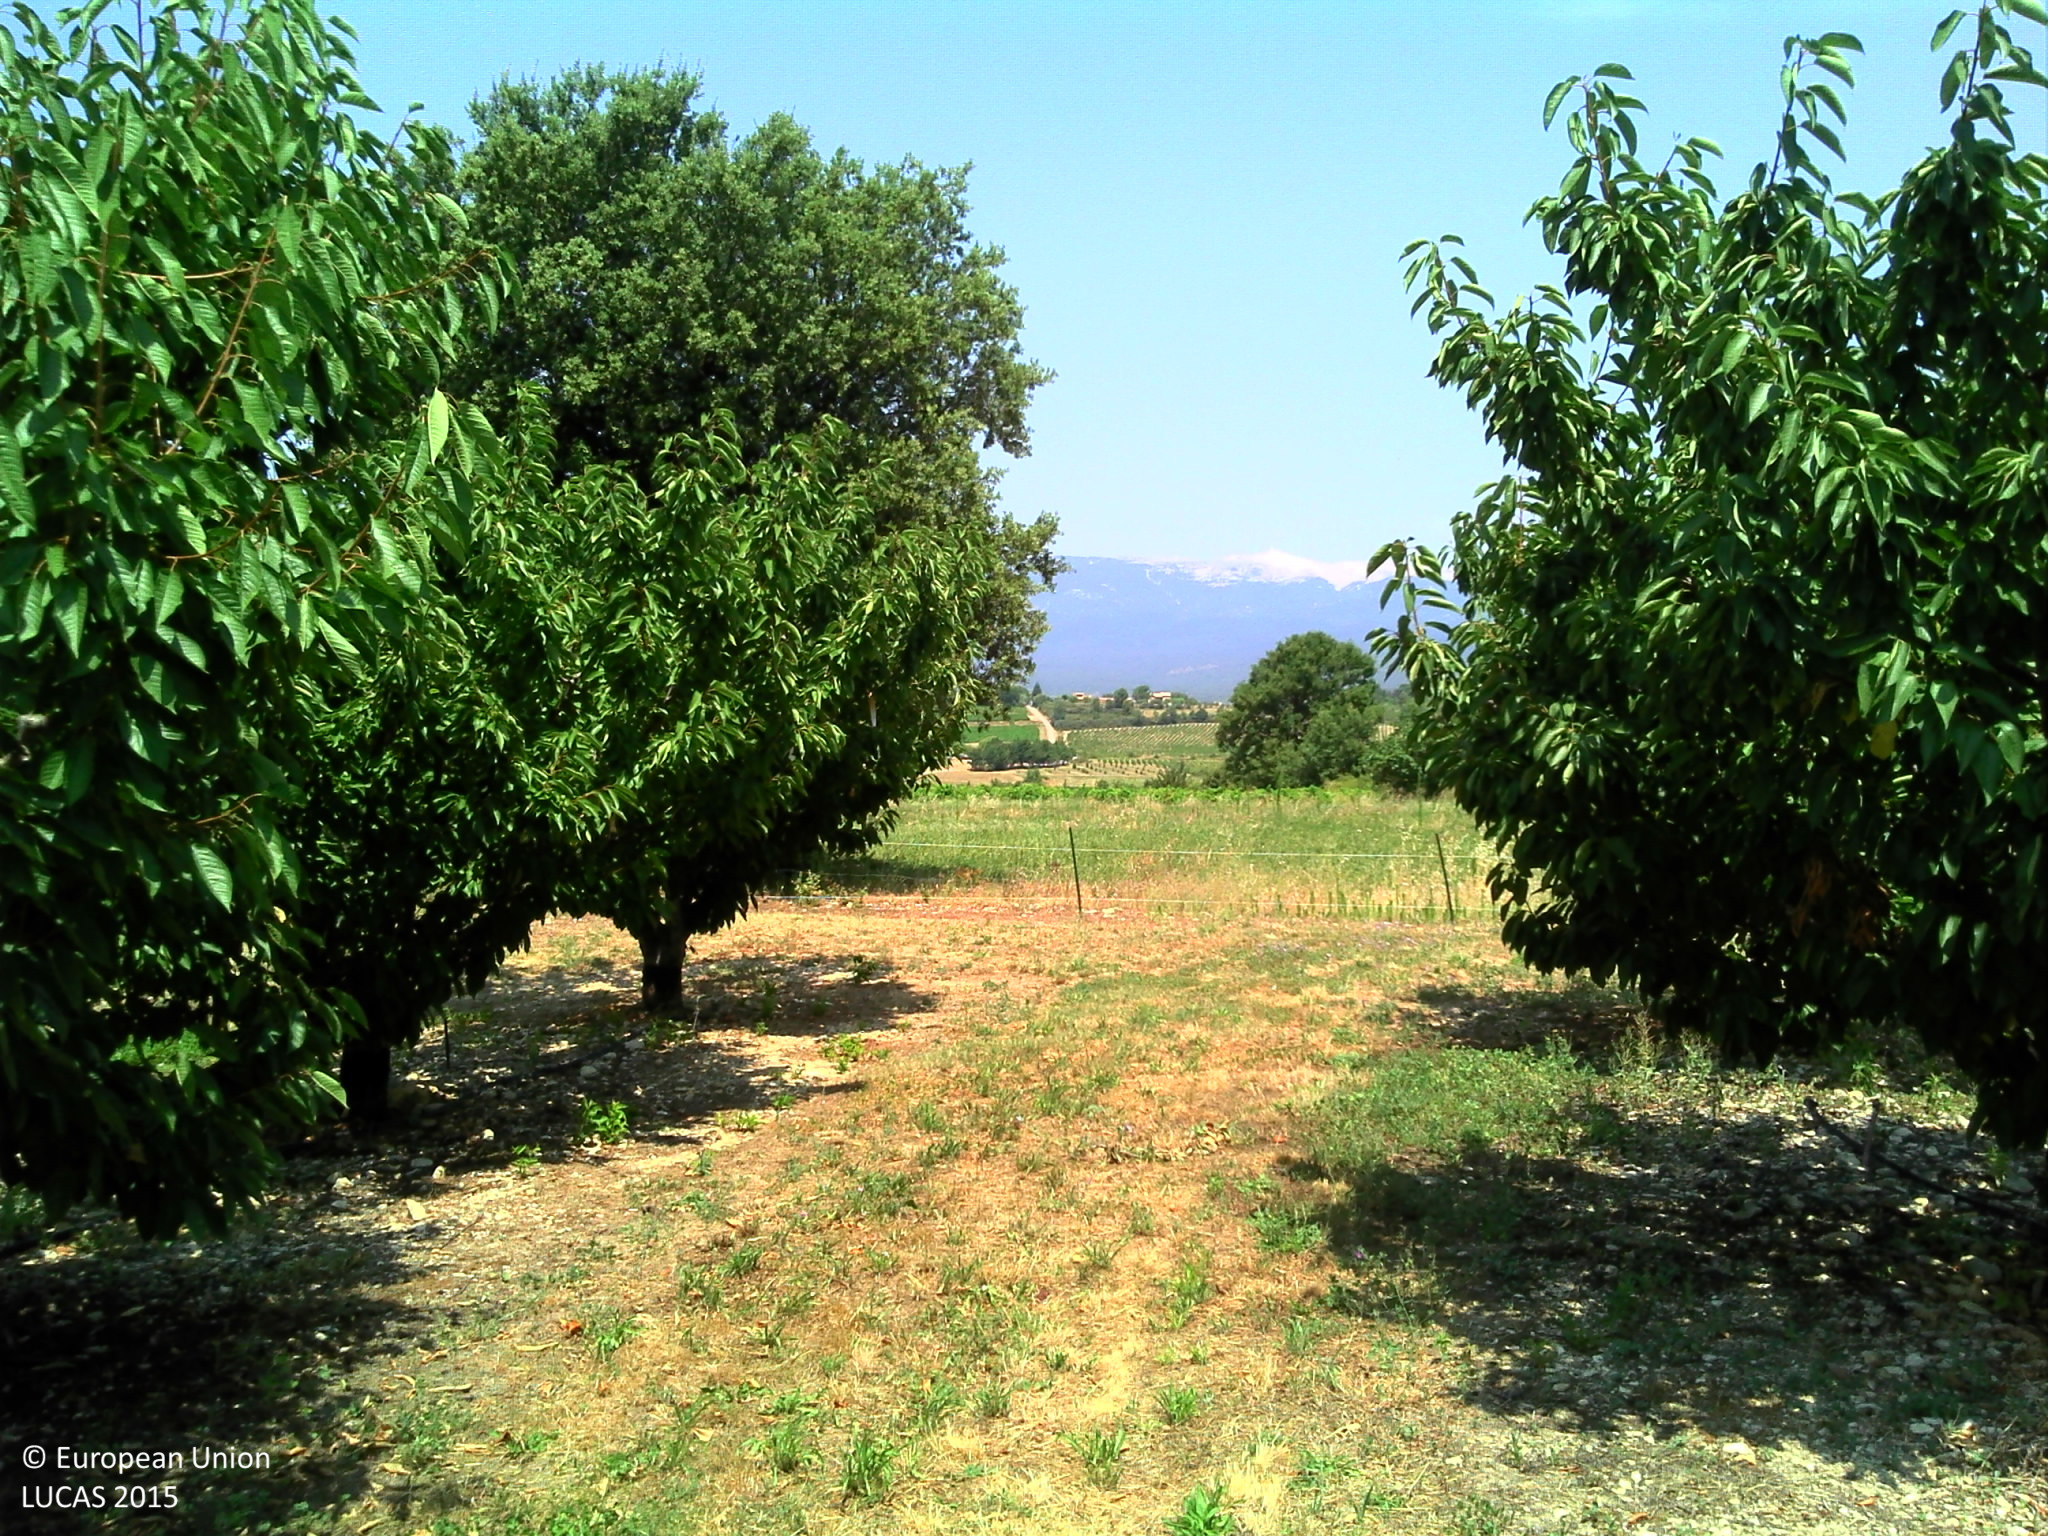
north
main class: Cropland
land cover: Cherry fruit
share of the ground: 50 - 75 %
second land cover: Grassland without tree/shrub cover
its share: 50 - 75 %
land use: Agriculture (excluding fallow land and kitchen gardens)
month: July
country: FR
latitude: 44.0421
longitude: 5.2286
